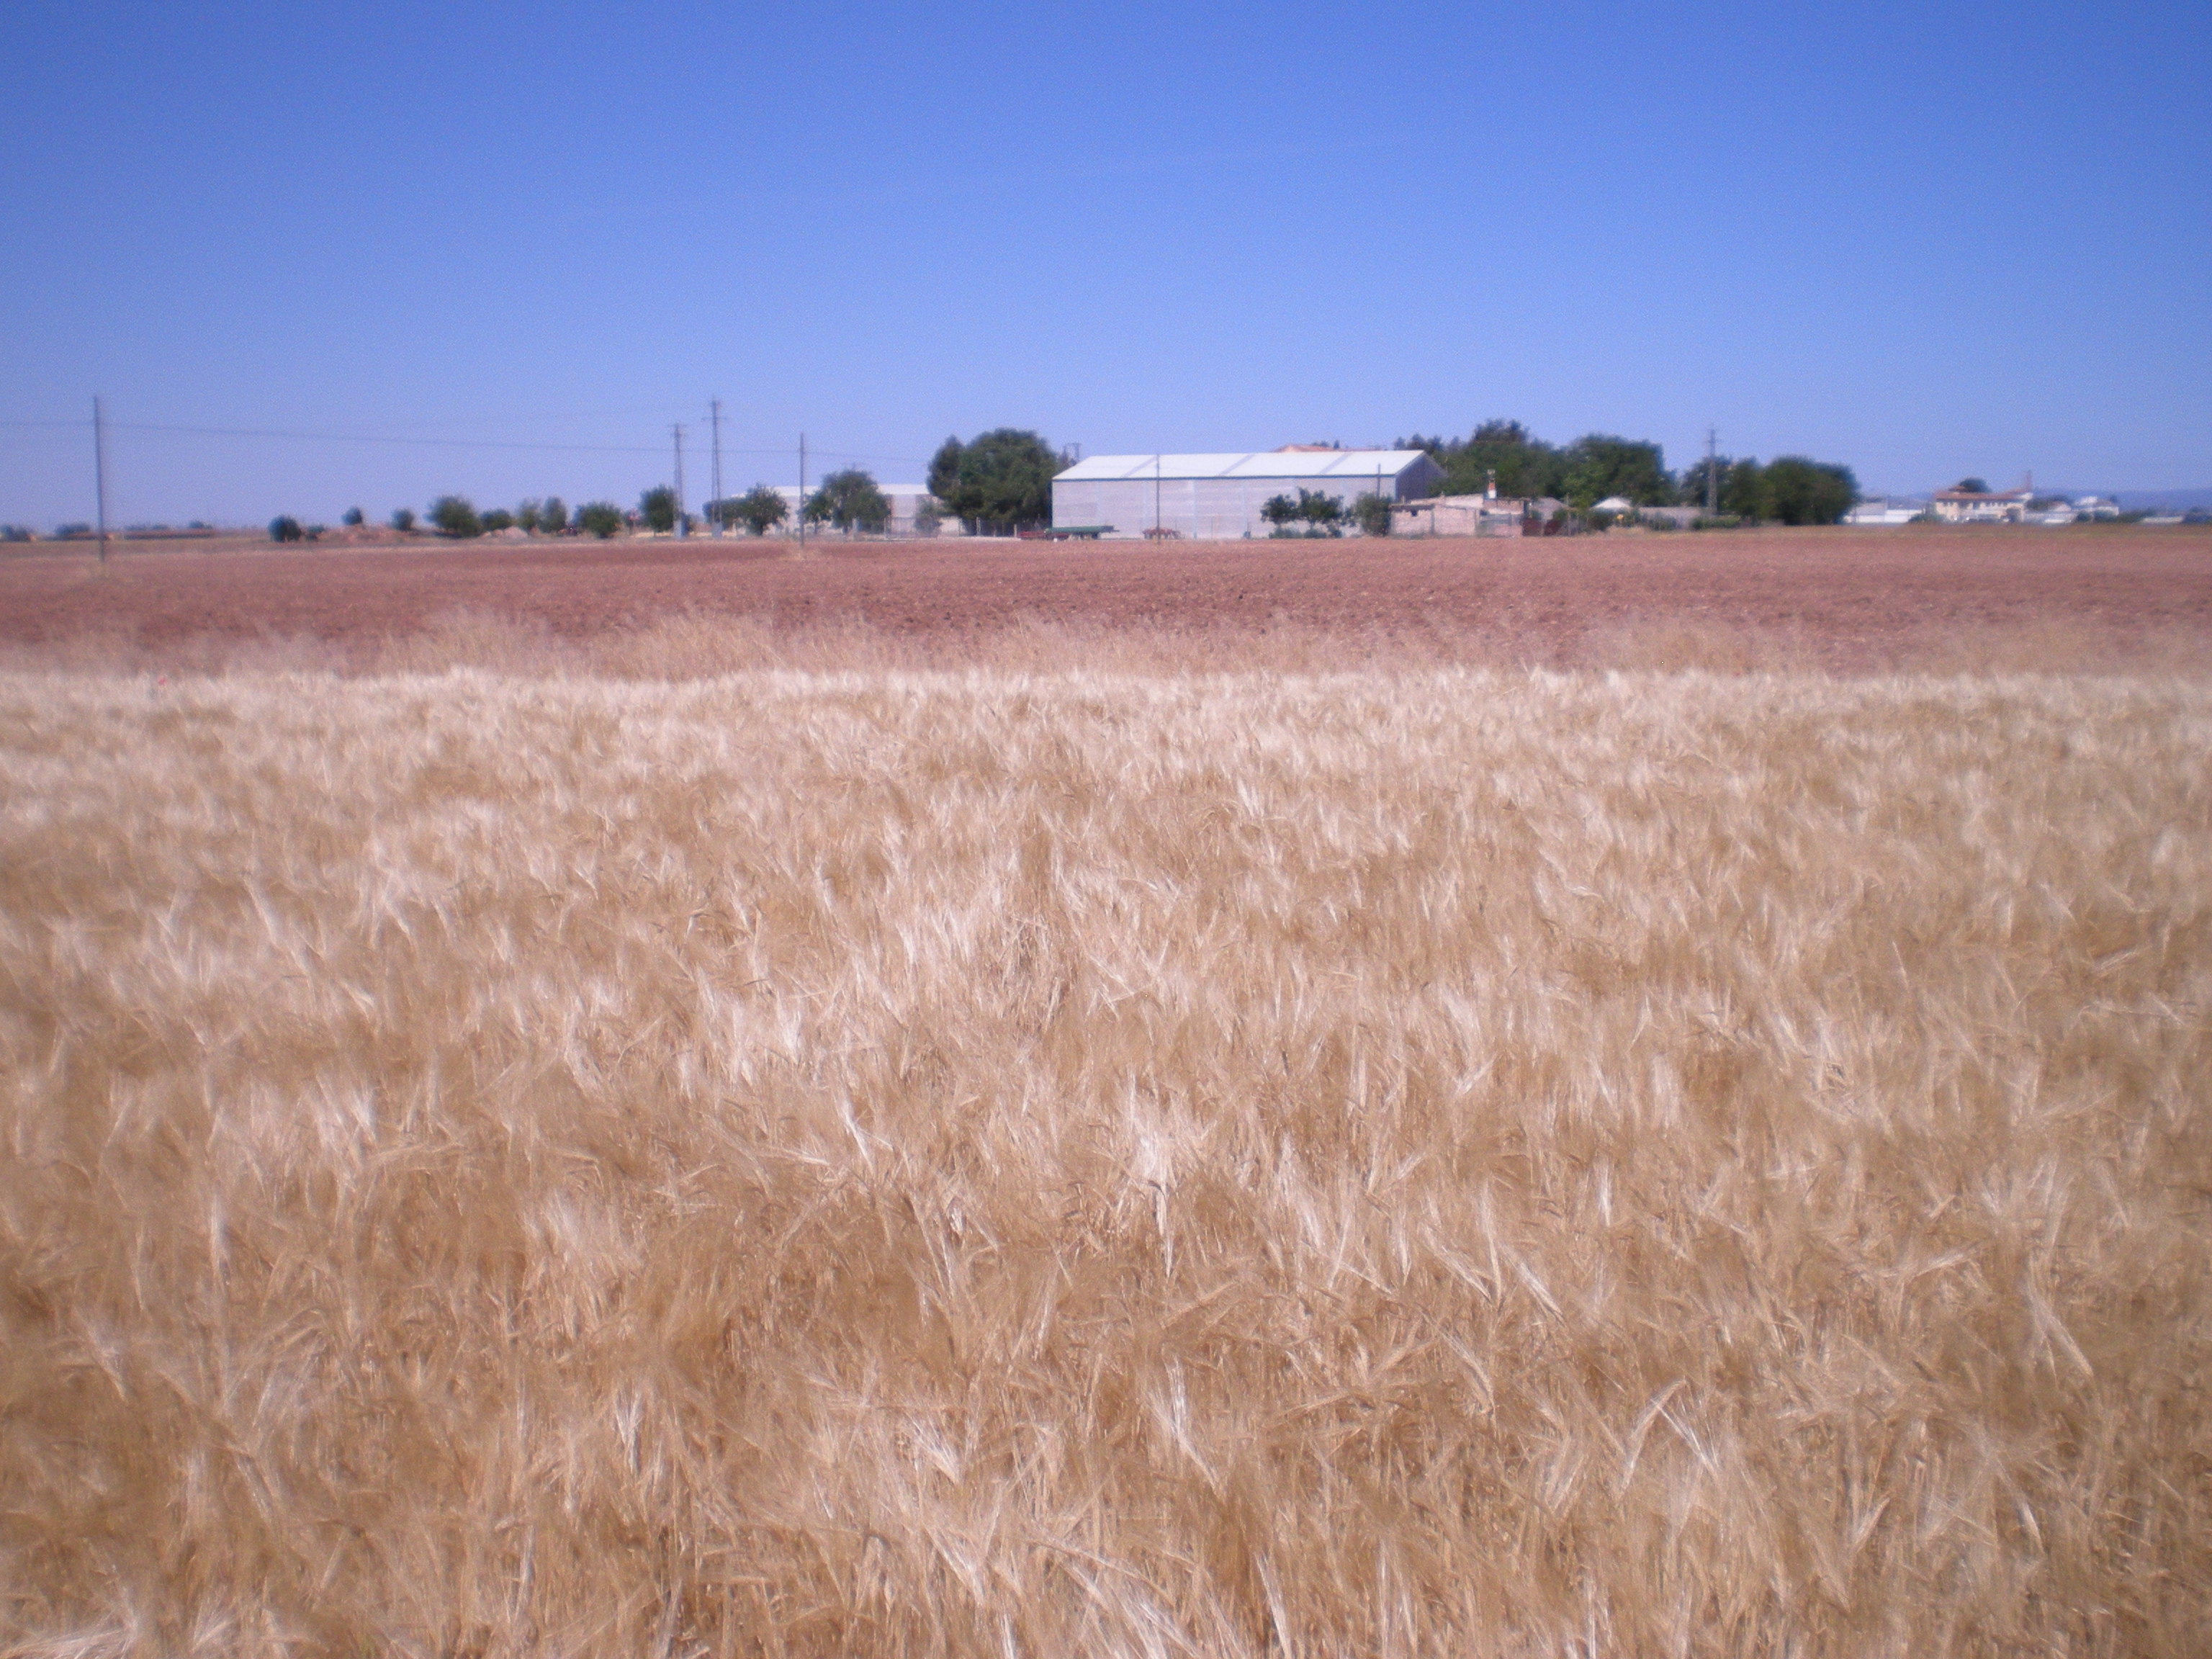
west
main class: Cropland
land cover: Barley
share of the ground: > 75 %
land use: Agriculture (excluding fallow land and kitchen gardens)
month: May
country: ES
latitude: 39.1669
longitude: -3.2208
